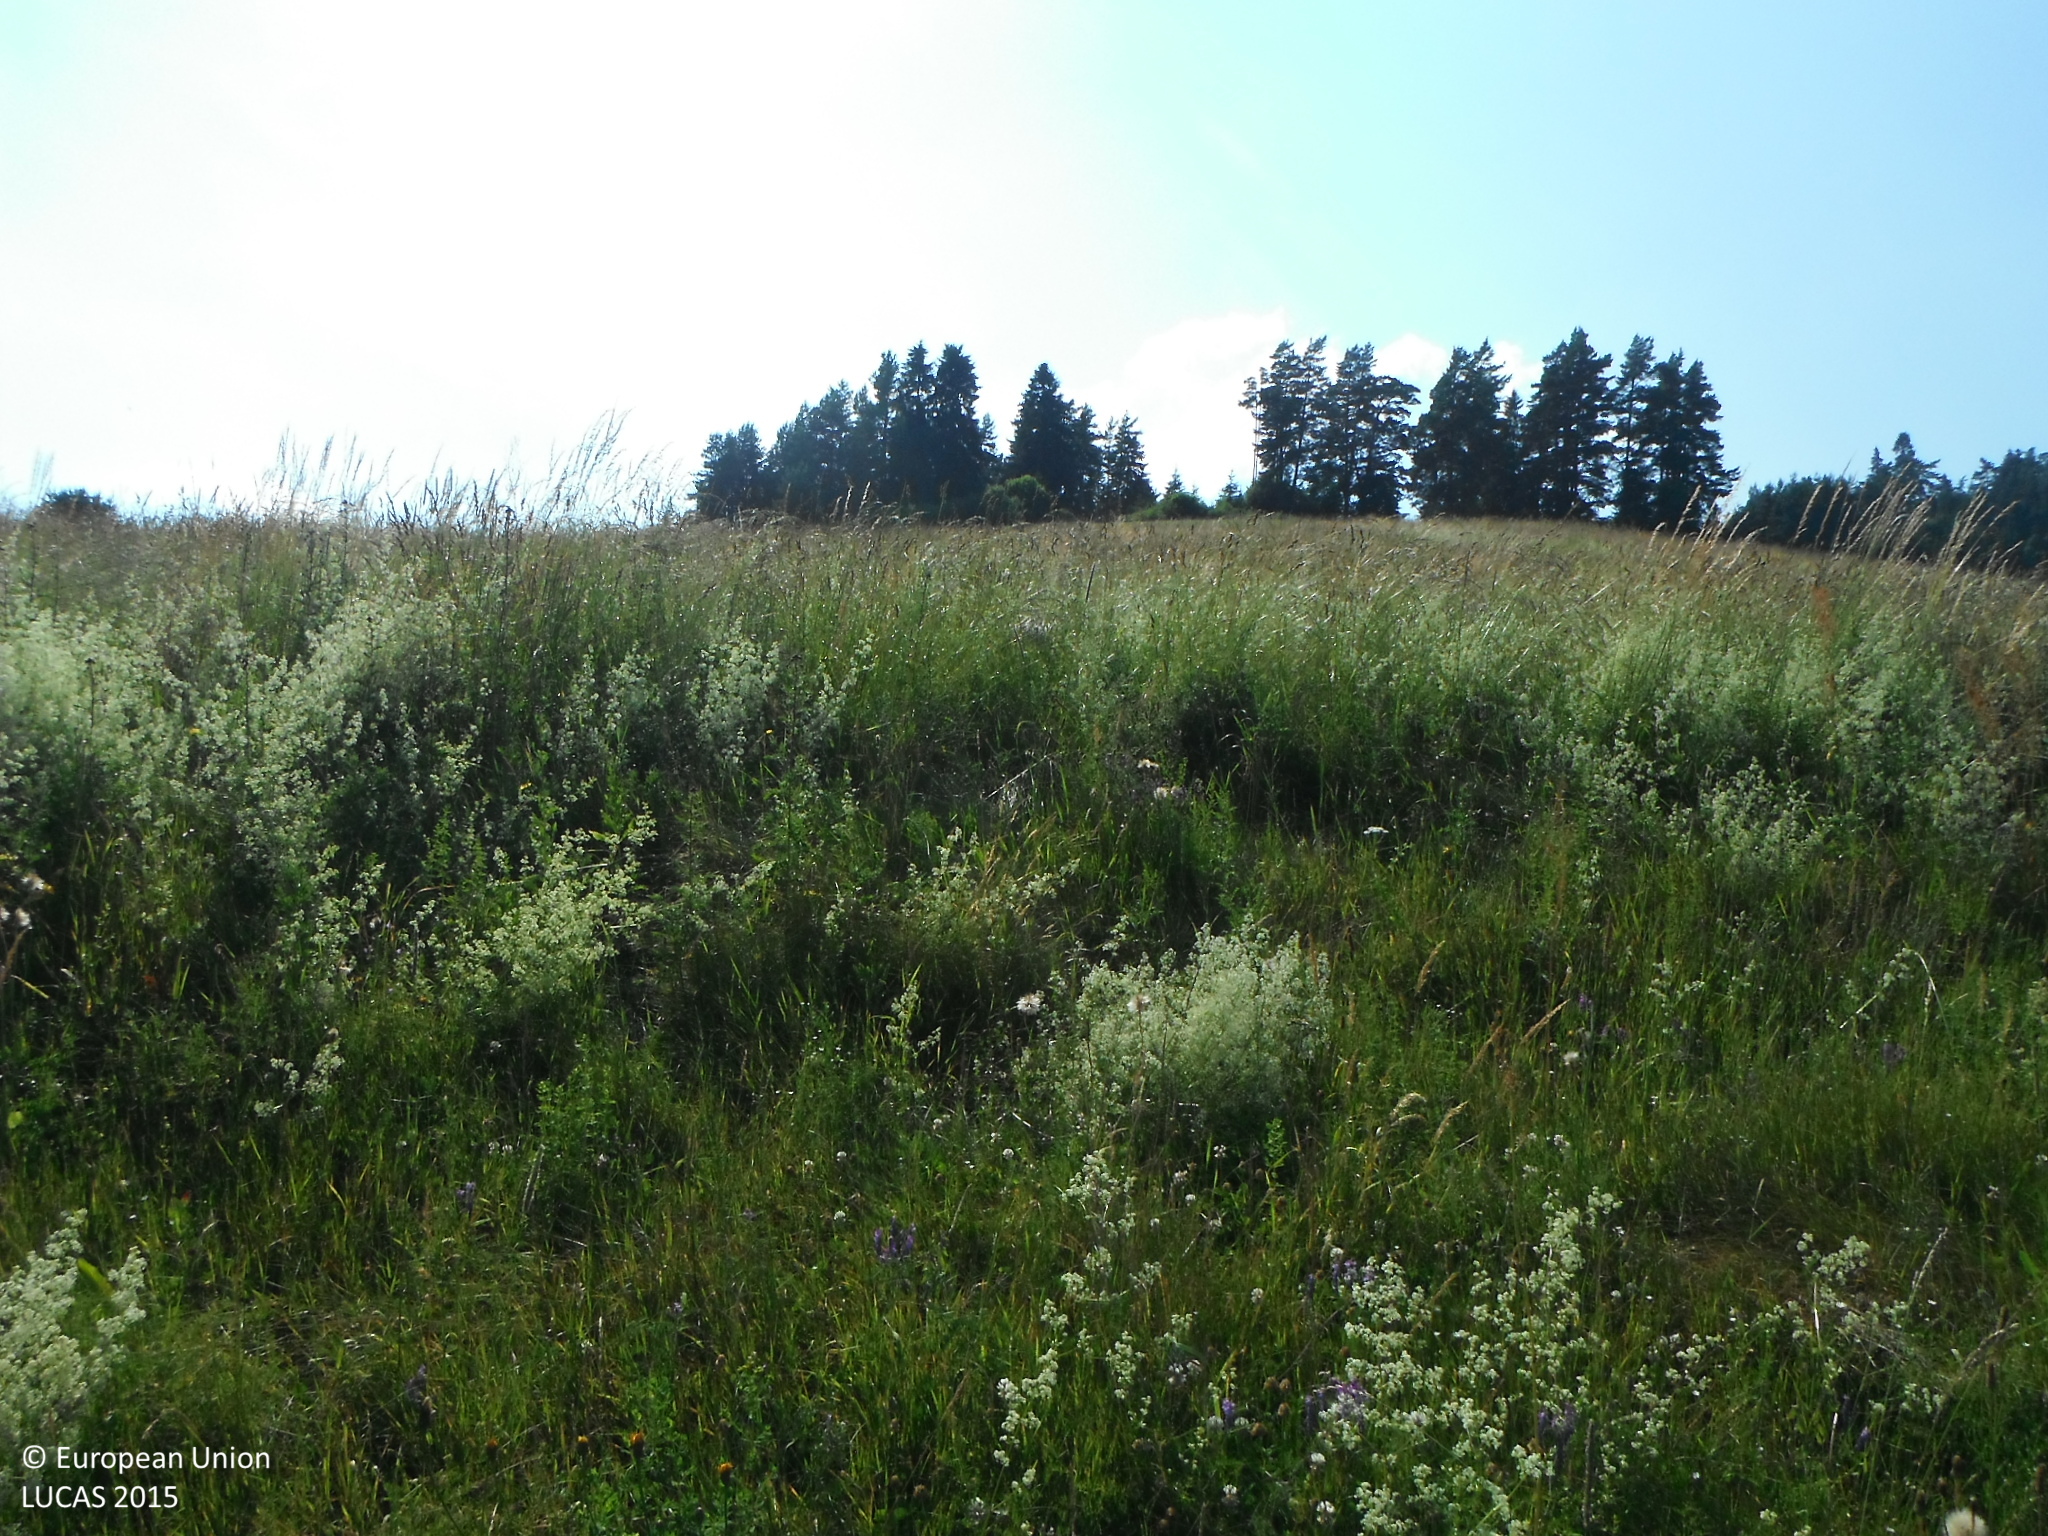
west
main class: Grassland
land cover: Grassland without tree/shrub cover
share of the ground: > 75 %
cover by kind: herbaceous plants 100 %
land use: Agriculture (excluding fallow land and kitchen gardens)
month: July
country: SK
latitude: 49.2785
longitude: 20.5250
